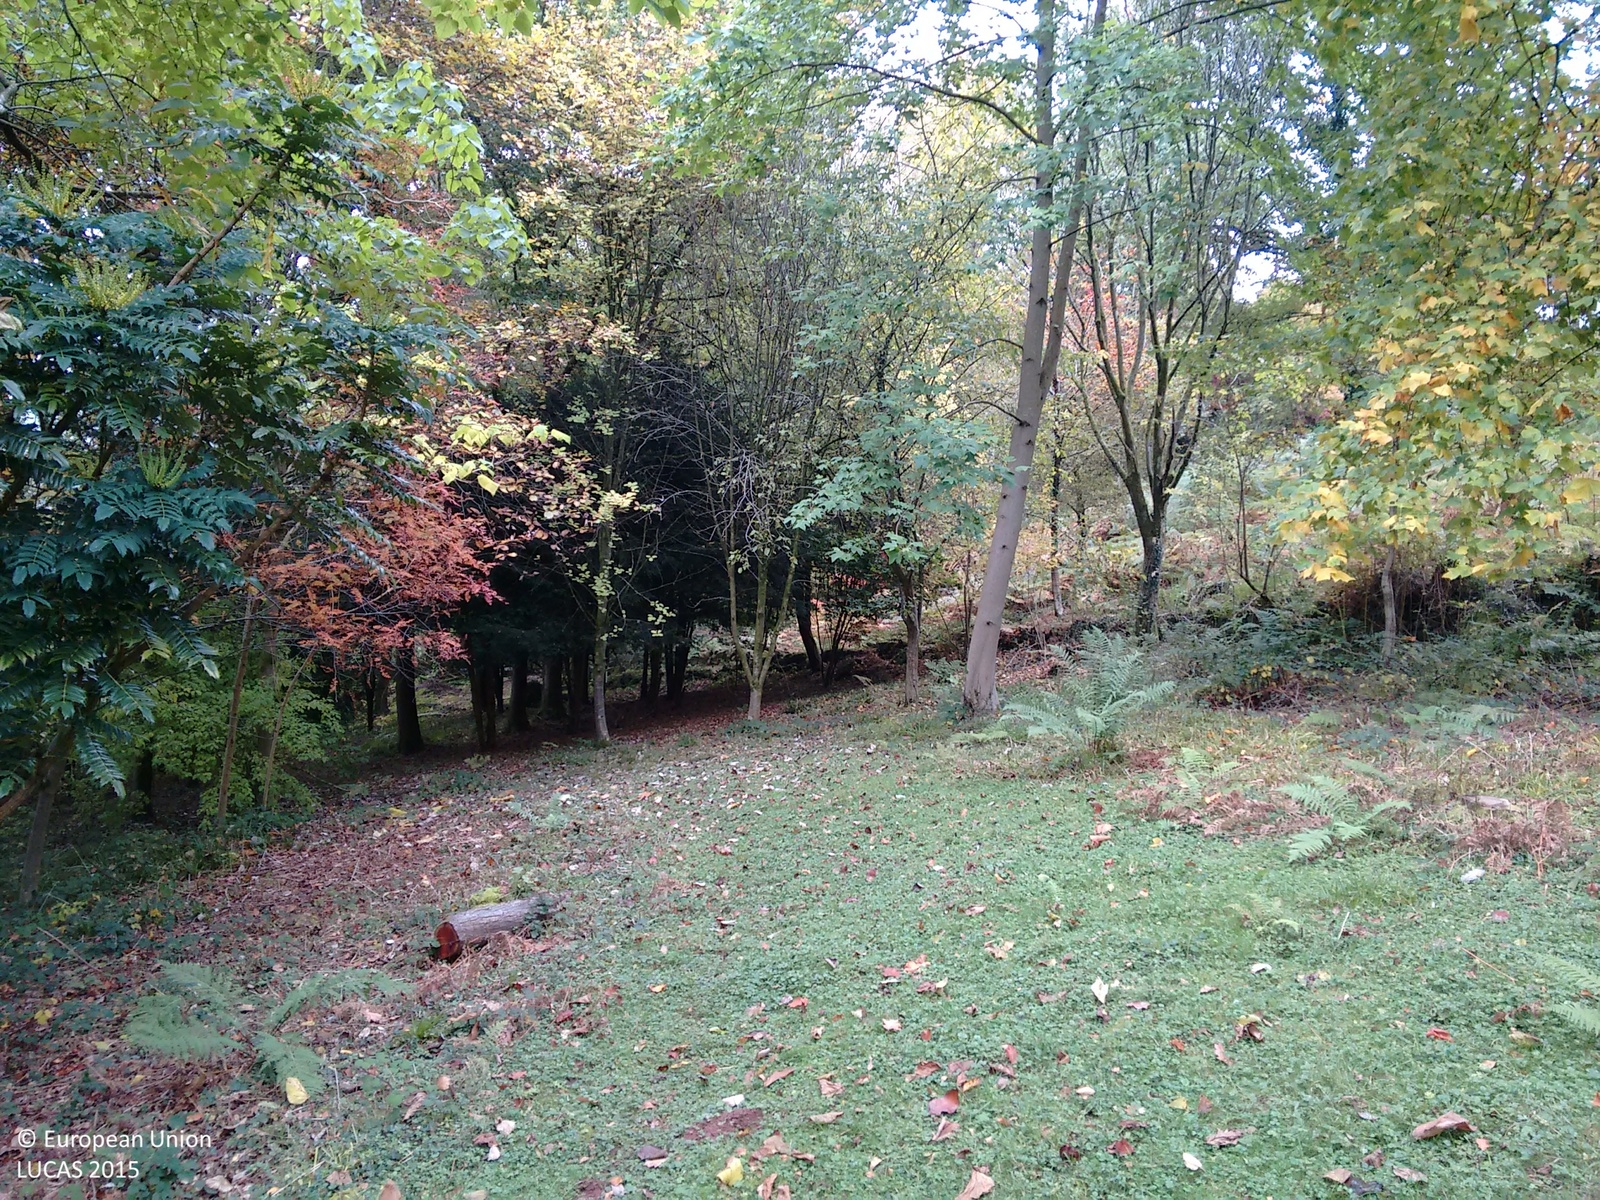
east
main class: Woodland
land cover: Broadleaved woodland
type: mesophytic deciduous forest
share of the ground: > 75 %
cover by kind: broadleaved forest trees 60 %, shrubs 20 %, herbaceous plants 20 %
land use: Residential
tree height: > 5 m
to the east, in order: Broadleaved woodland; Tracks; Dry stone walls; Broadleaved woodland; Tracks; Broadleaved woodland; Electric lines; Broadleaved woodland; Dry stone walls; Grass margins; Paved roads, cycling and walking lanes; Grass margins; Dry stone walls; Broadleaved woodland
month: October
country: GB
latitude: 51.7335
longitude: -2.6520
